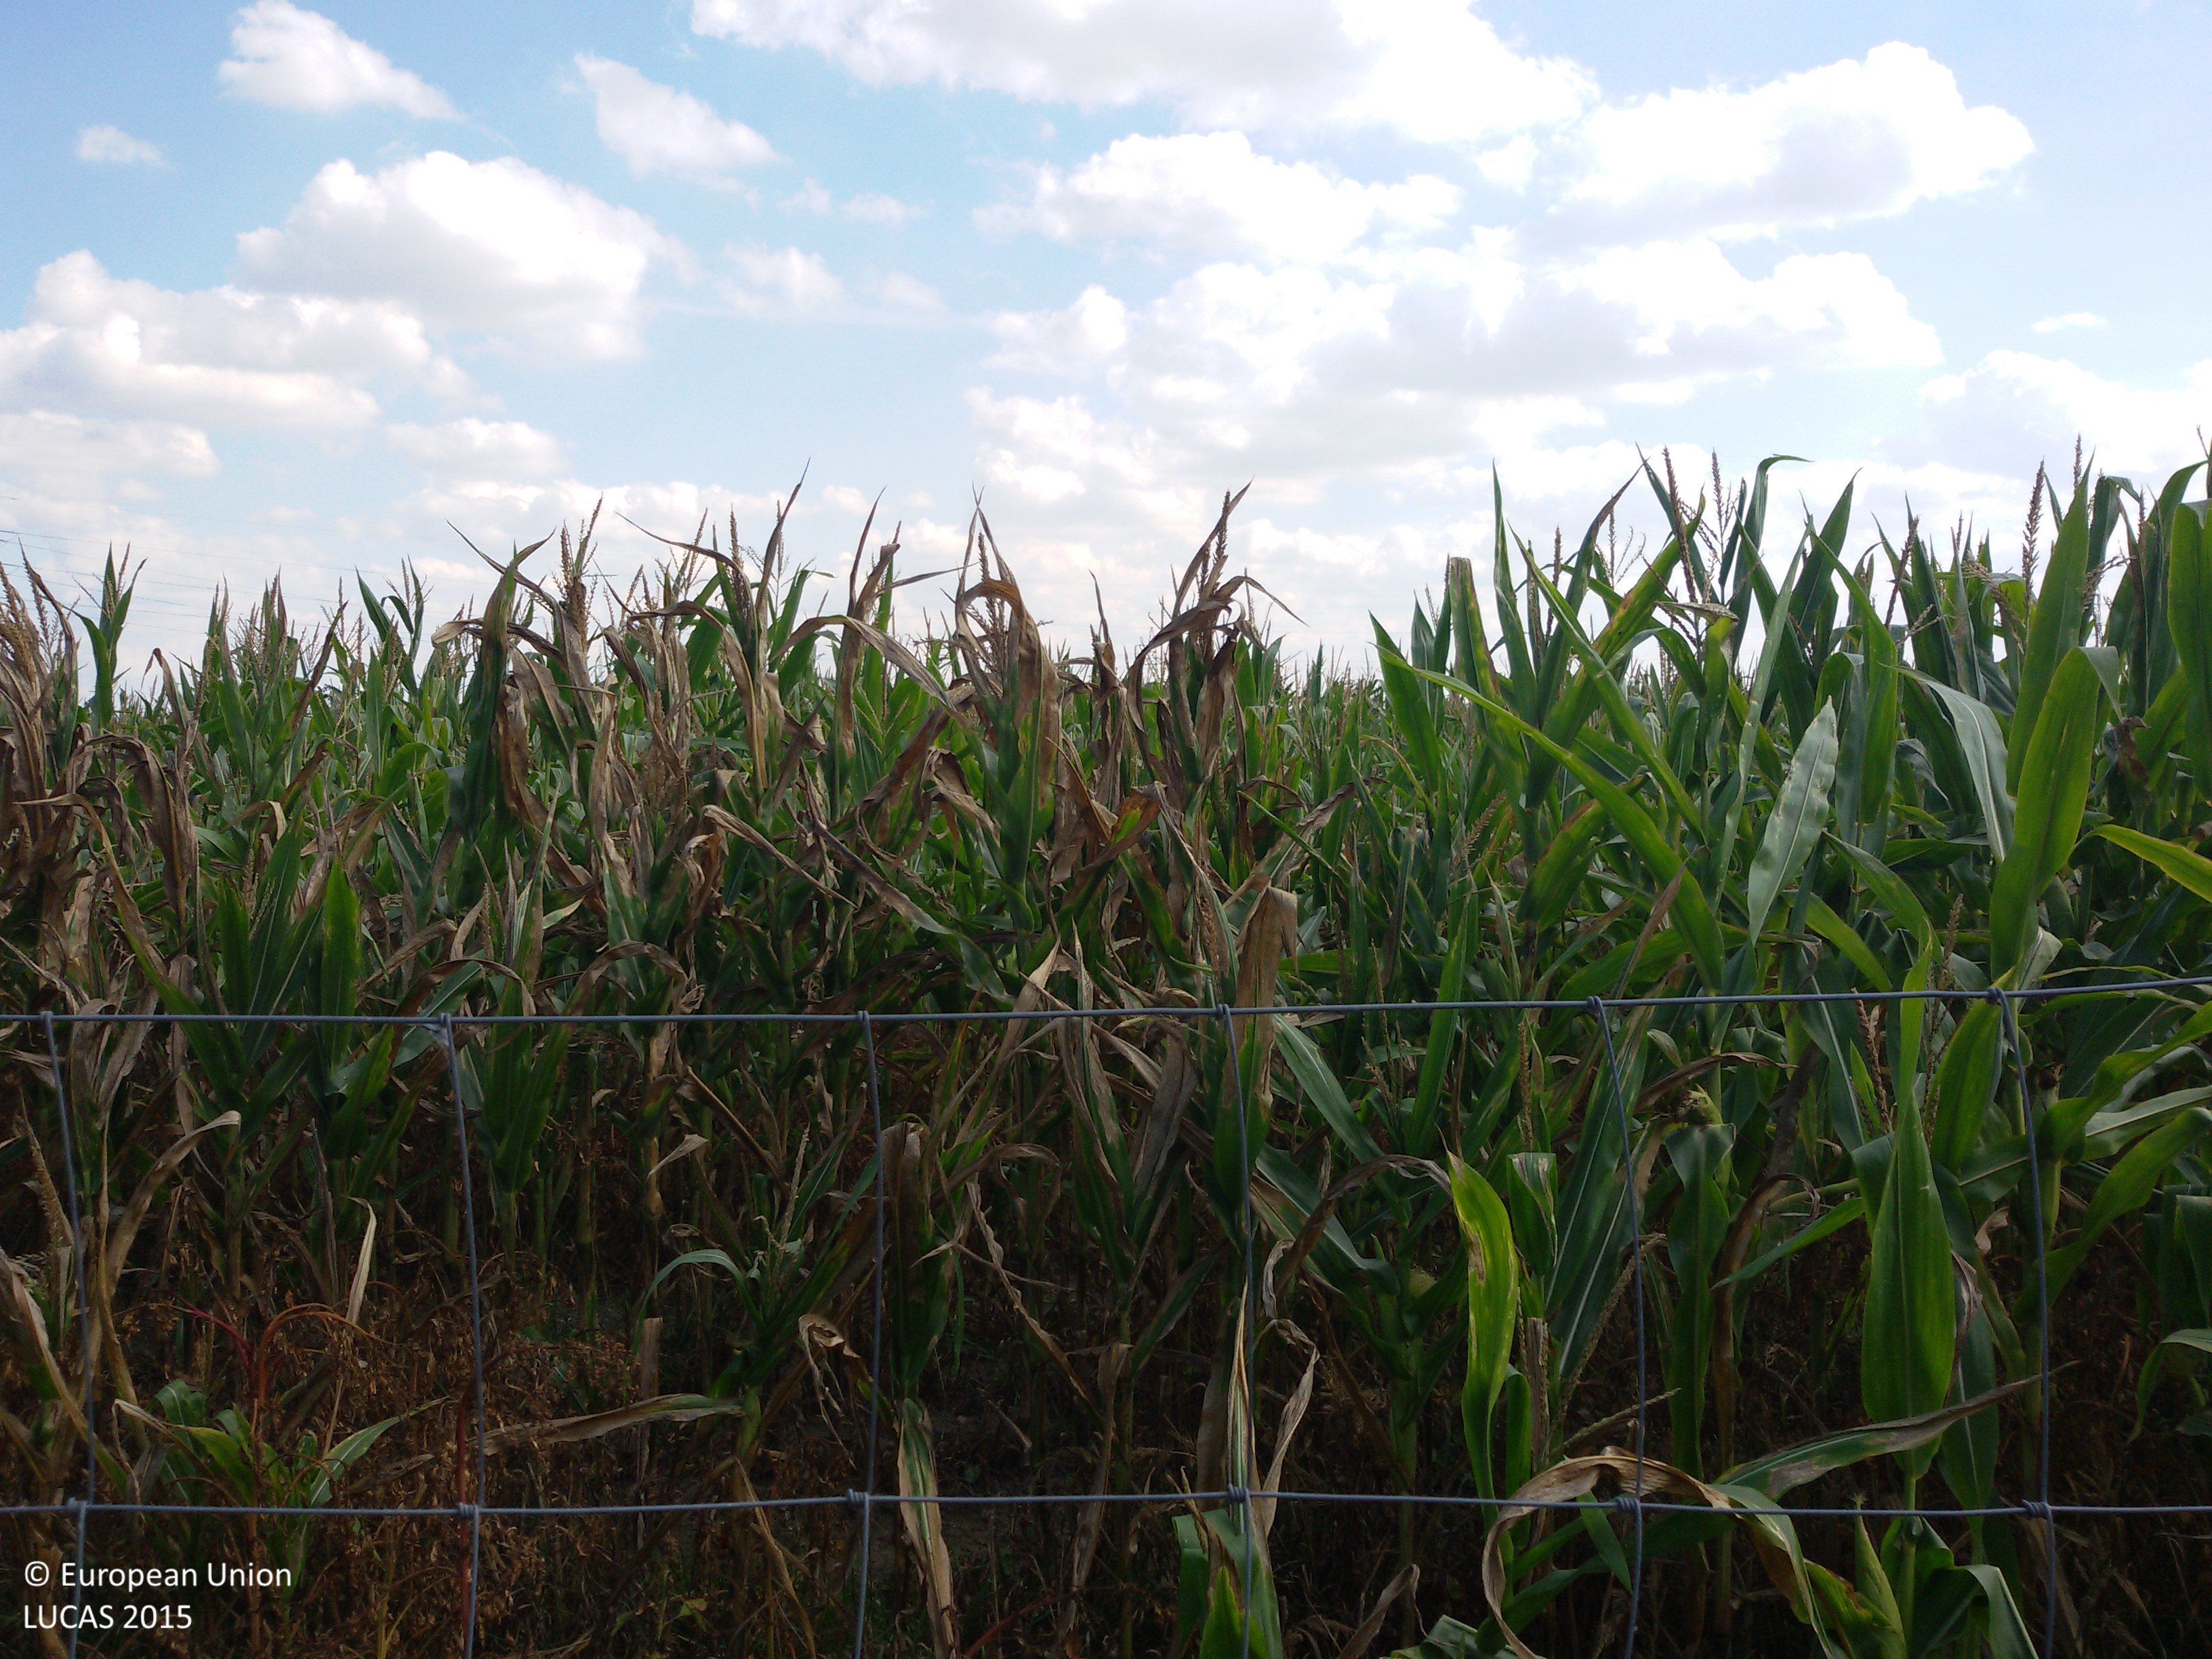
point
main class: Cropland
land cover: Maize
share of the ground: > 75 %
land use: Agriculture (excluding fallow land and kitchen gardens)
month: September
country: PL
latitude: 52.1289
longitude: 17.9474
